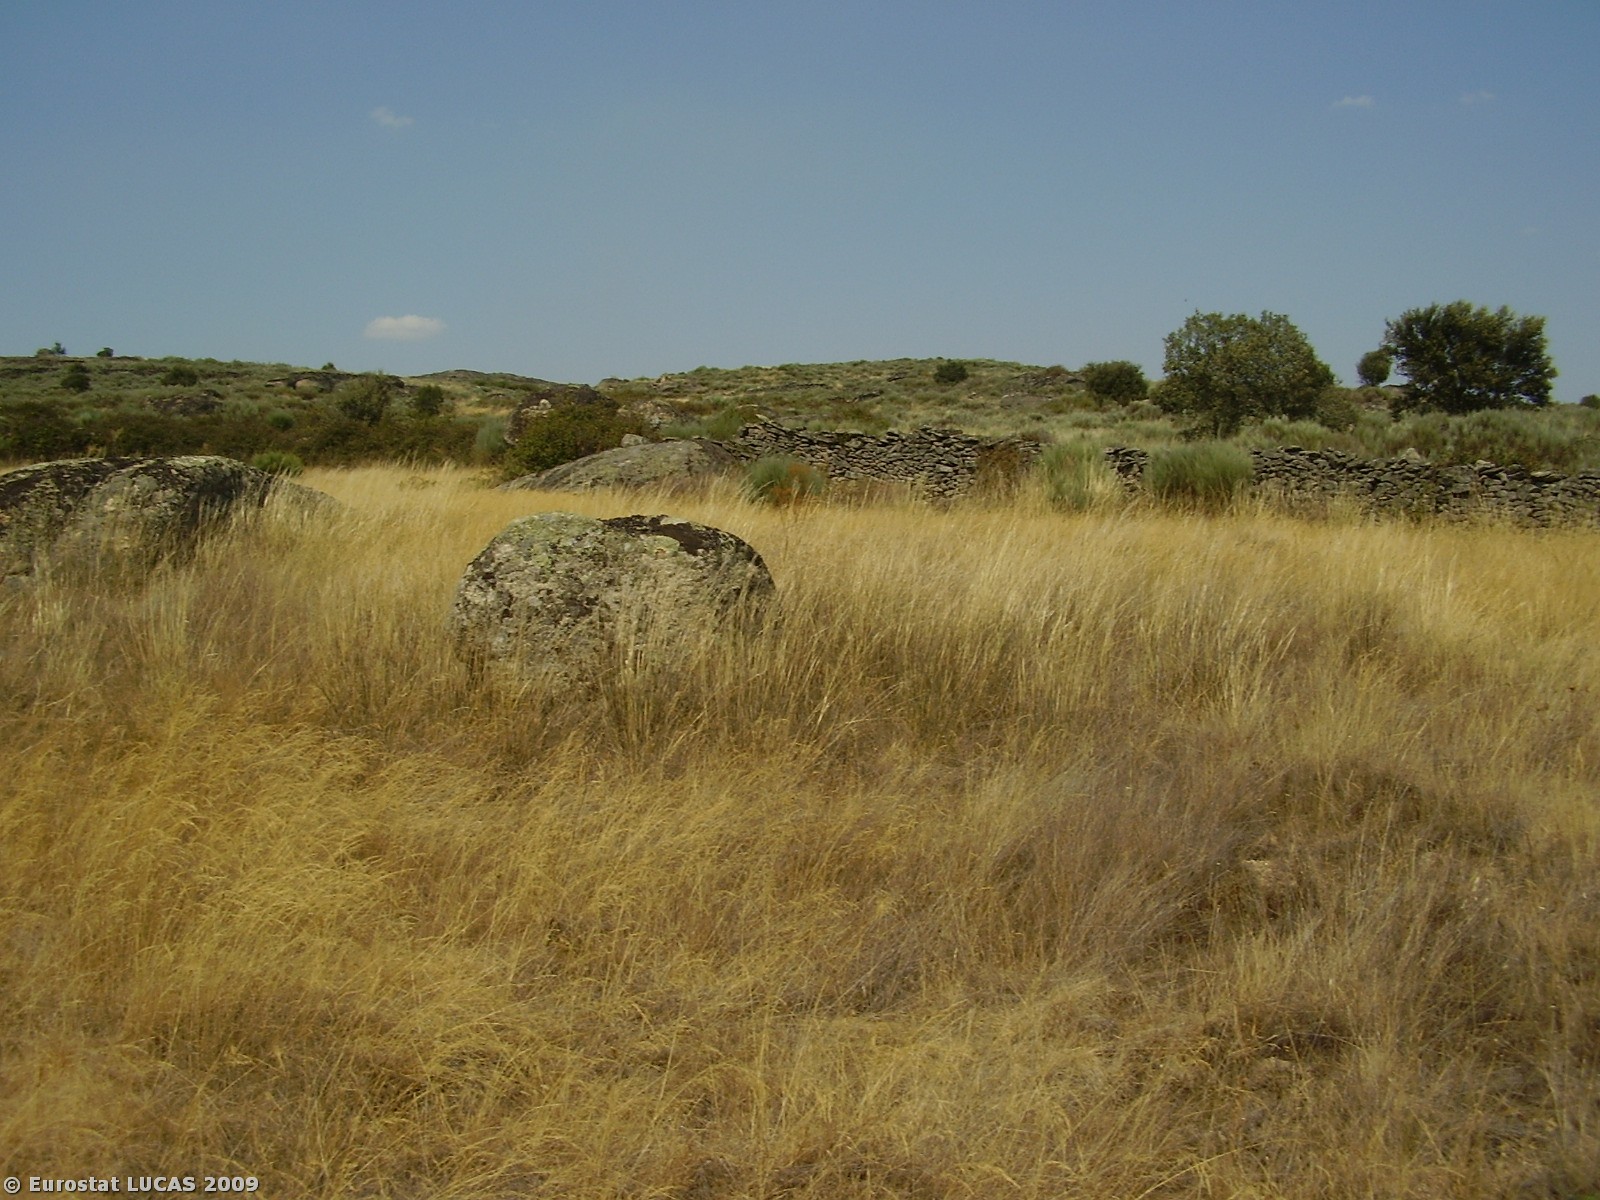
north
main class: Grassland
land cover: Grassland with sparse tree/shrub cover
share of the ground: > 75 %
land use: Fallow land
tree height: > 5 m
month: August
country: PT
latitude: 41.1689
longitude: -6.7789
